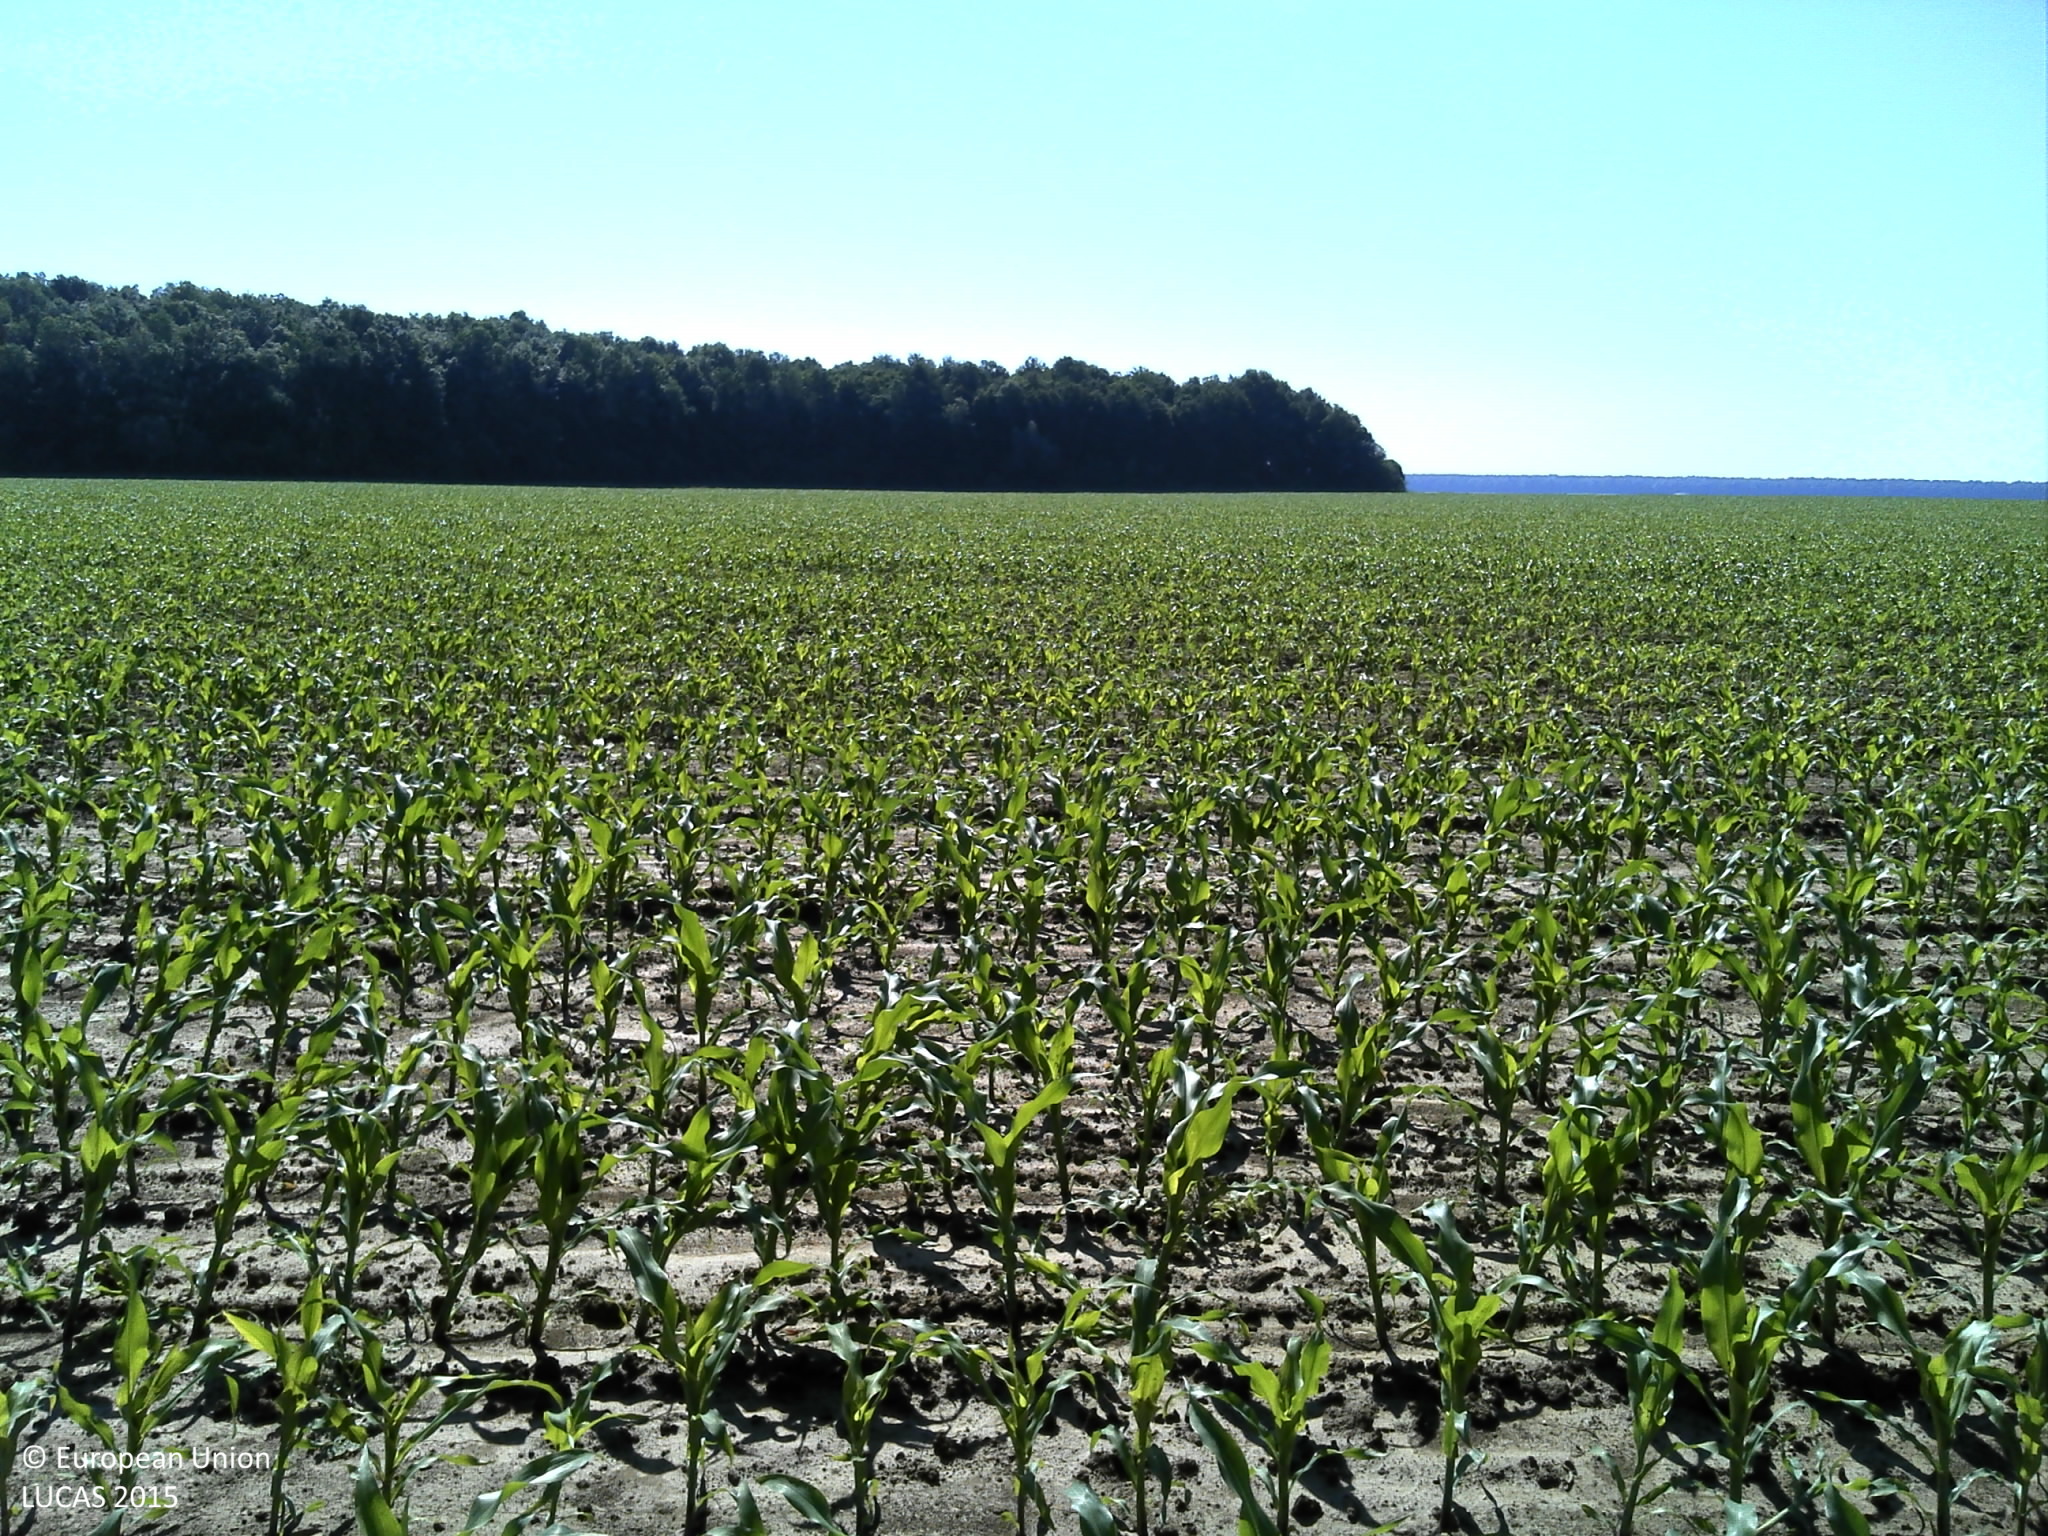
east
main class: Cropland
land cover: Maize
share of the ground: 50 - 75 %
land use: Agriculture (excluding fallow land and kitchen gardens)
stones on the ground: < 10 %
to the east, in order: Maize
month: May
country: HR
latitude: 45.6014
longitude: 17.9656
